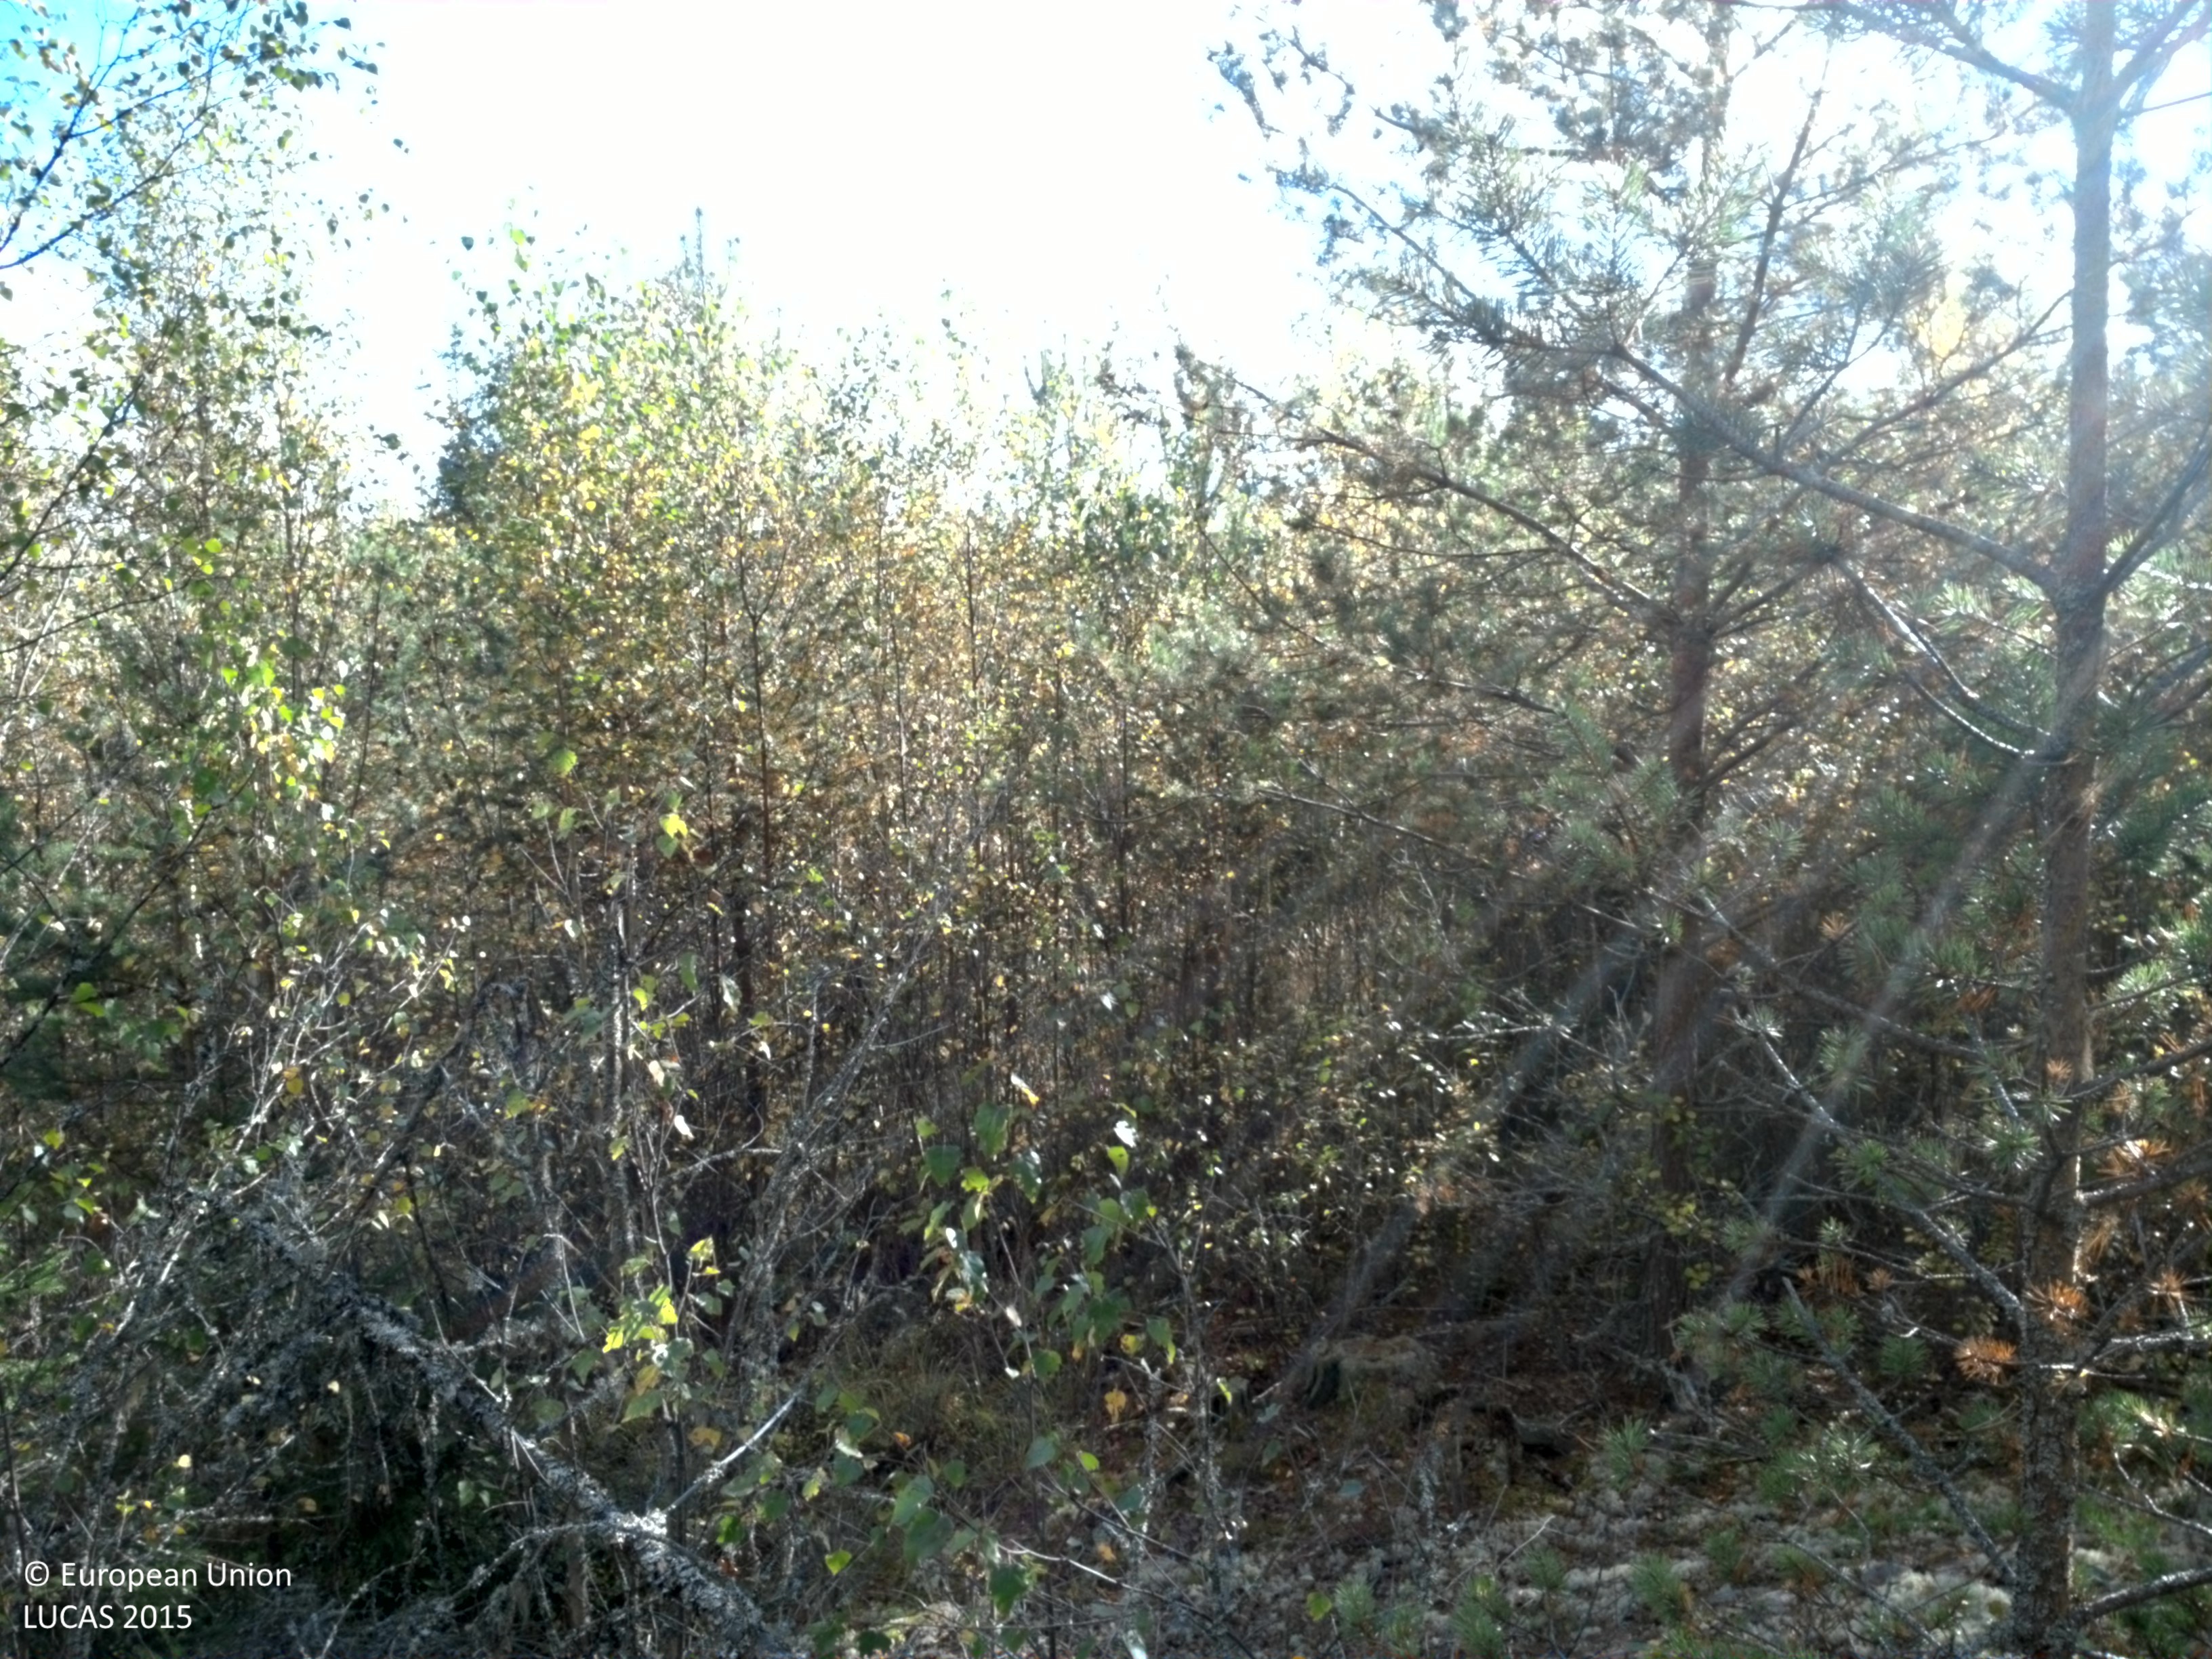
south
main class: Woodland
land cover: Spruce dominated mixed woodland
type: boreal forest
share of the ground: 50 - 75 %
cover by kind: coniferous forest trees 35 %, shrubs 20 %, herbaceous plants 20 %, broadleaved forest trees 15 %, unconsolidated bare surface 10 %
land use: Forestry
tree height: > 5 m
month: September
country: SE
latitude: 60.1185
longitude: 16.5582
